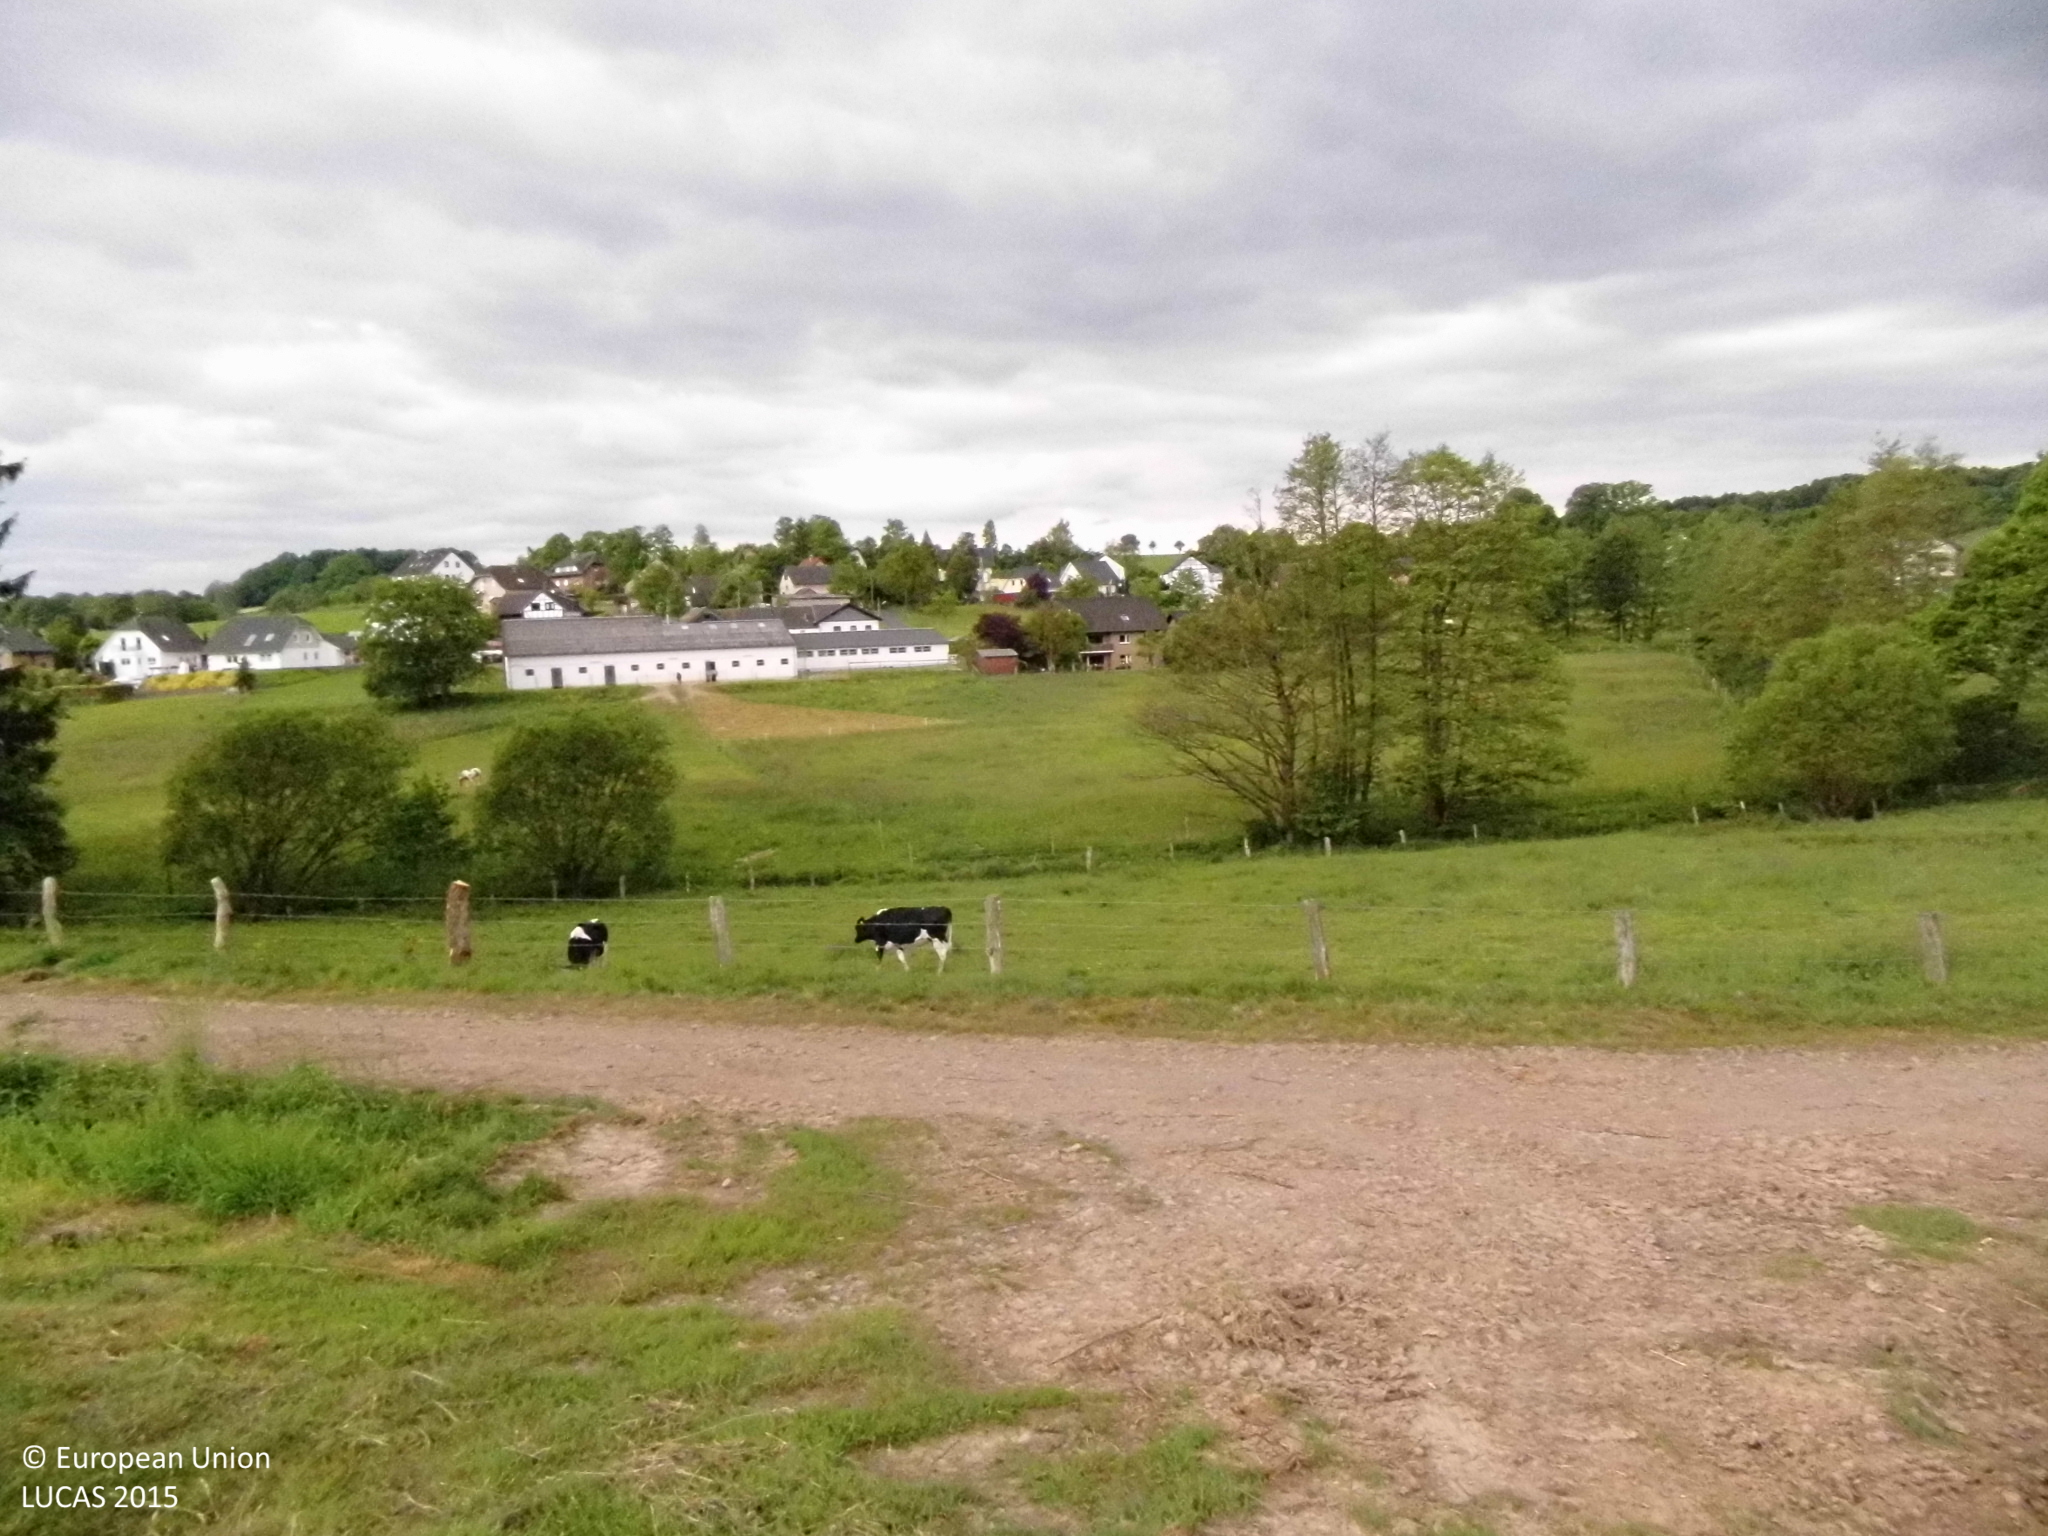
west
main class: Grassland
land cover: Grassland with sparse tree/shrub cover
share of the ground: > 75 %
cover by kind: herbaceous plants 90 %, broadleaved forest trees 5 %, unconsolidated bare surface 5 %
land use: Agriculture (excluding fallow land and kitchen gardens)
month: May
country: DE
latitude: 50.8934
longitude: 7.4554
